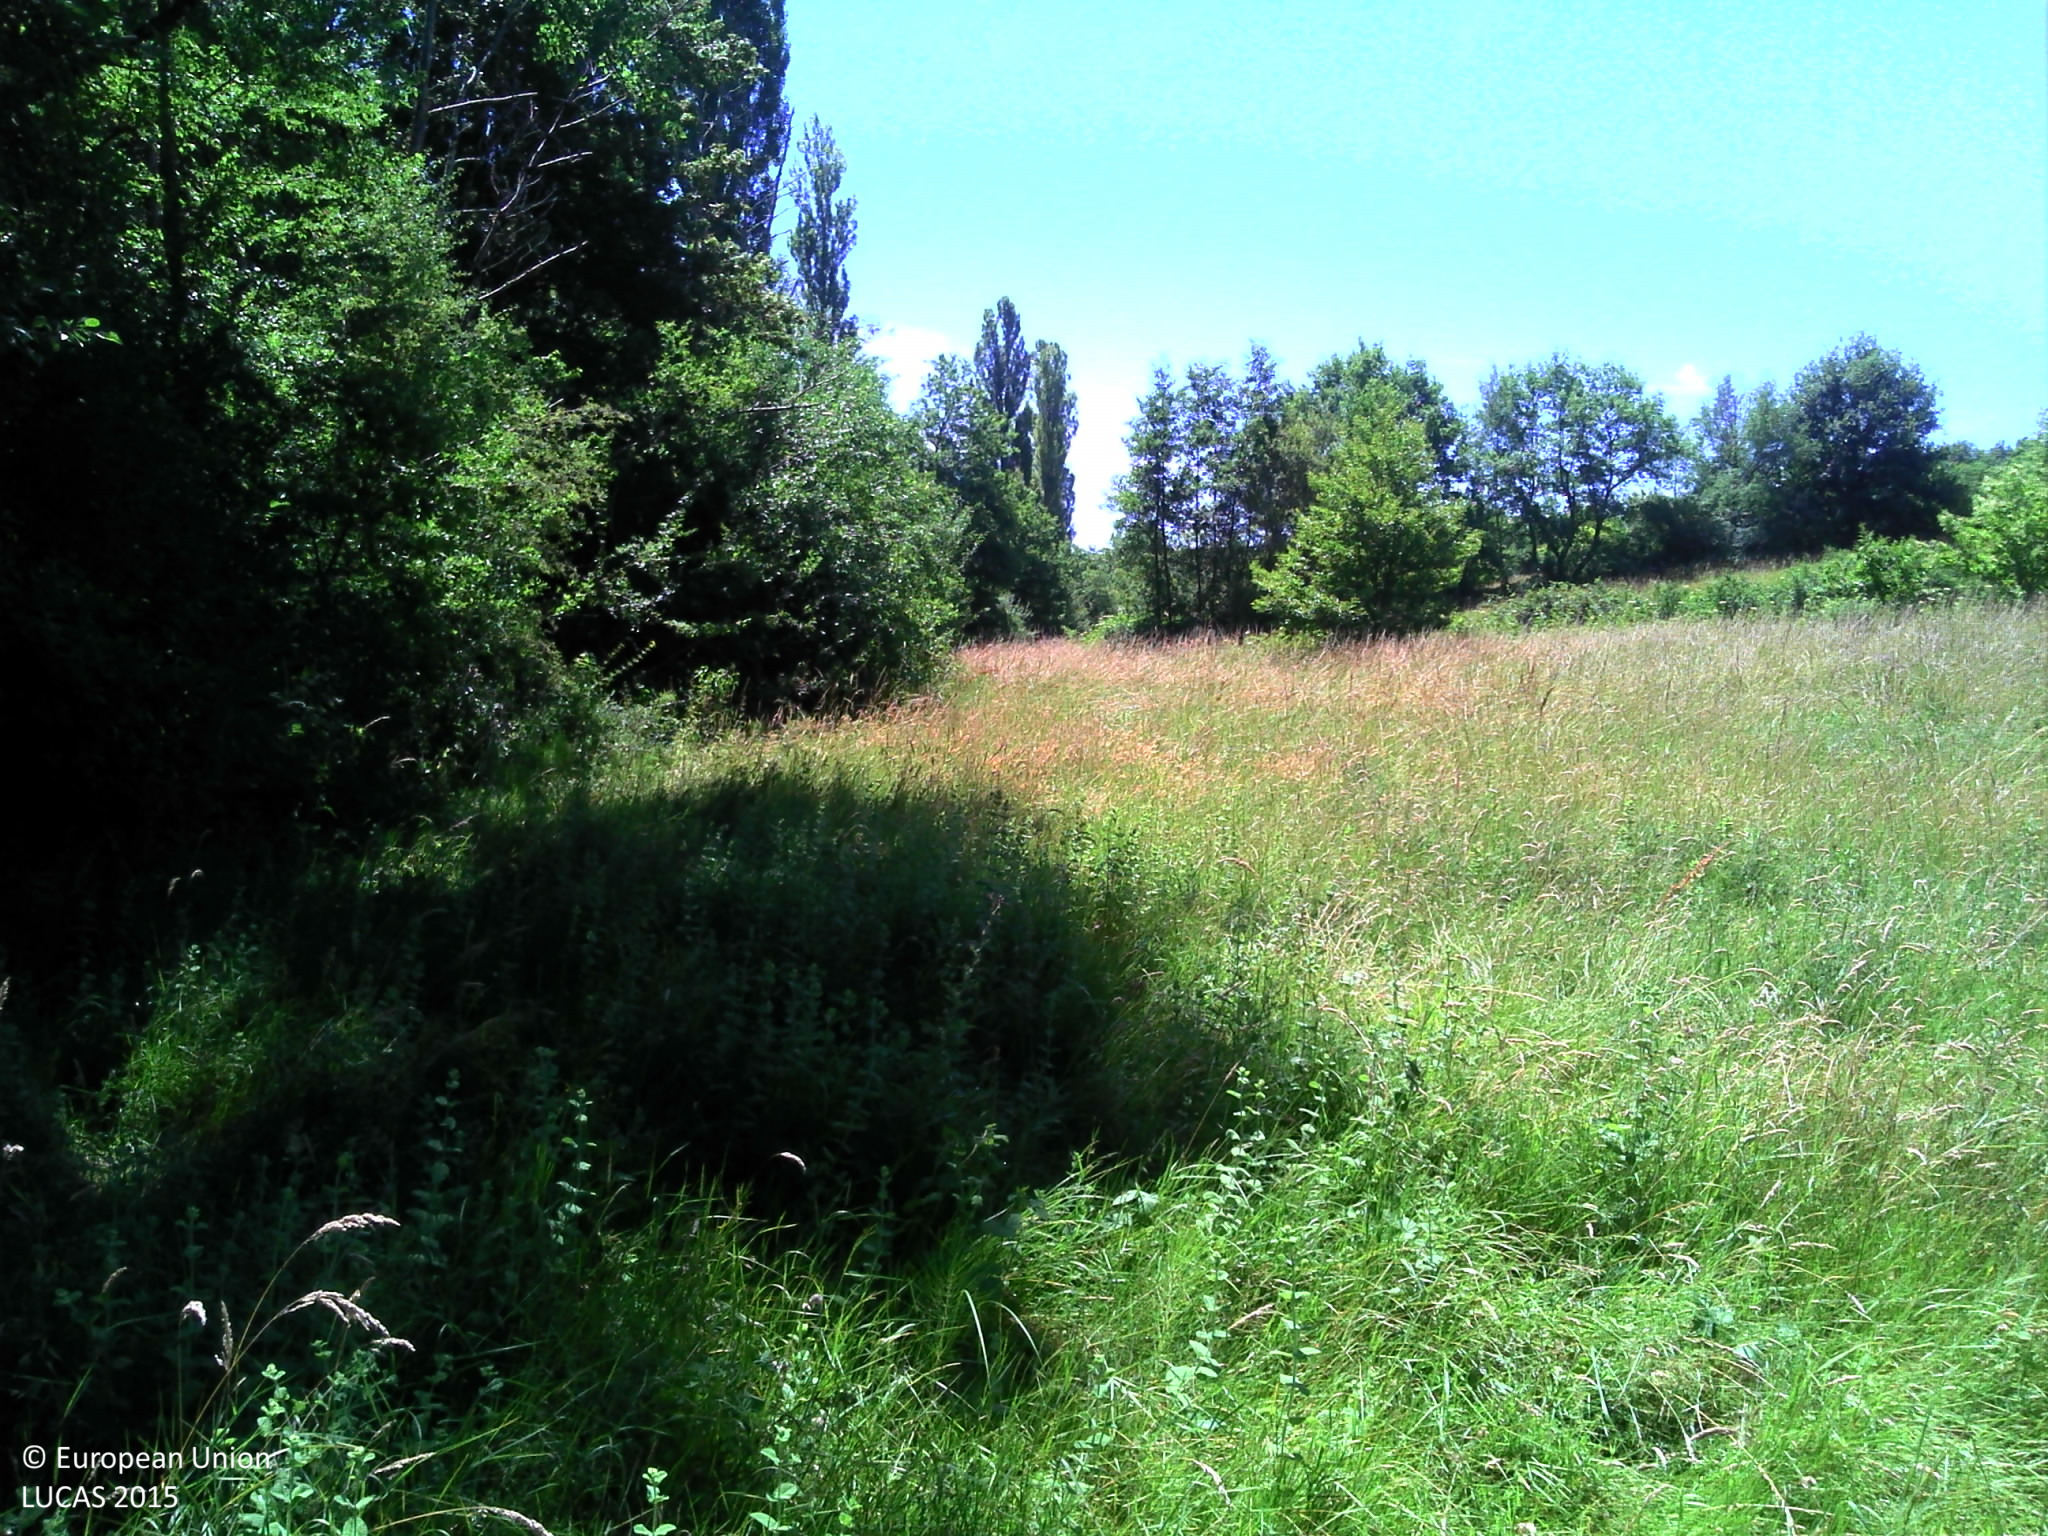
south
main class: Grassland
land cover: Grassland without tree/shrub cover
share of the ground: > 75 %
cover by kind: herbaceous plants 100 %
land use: Agriculture (excluding fallow land and kitchen gardens)
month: June
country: FR
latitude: 43.8965
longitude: 1.5485
